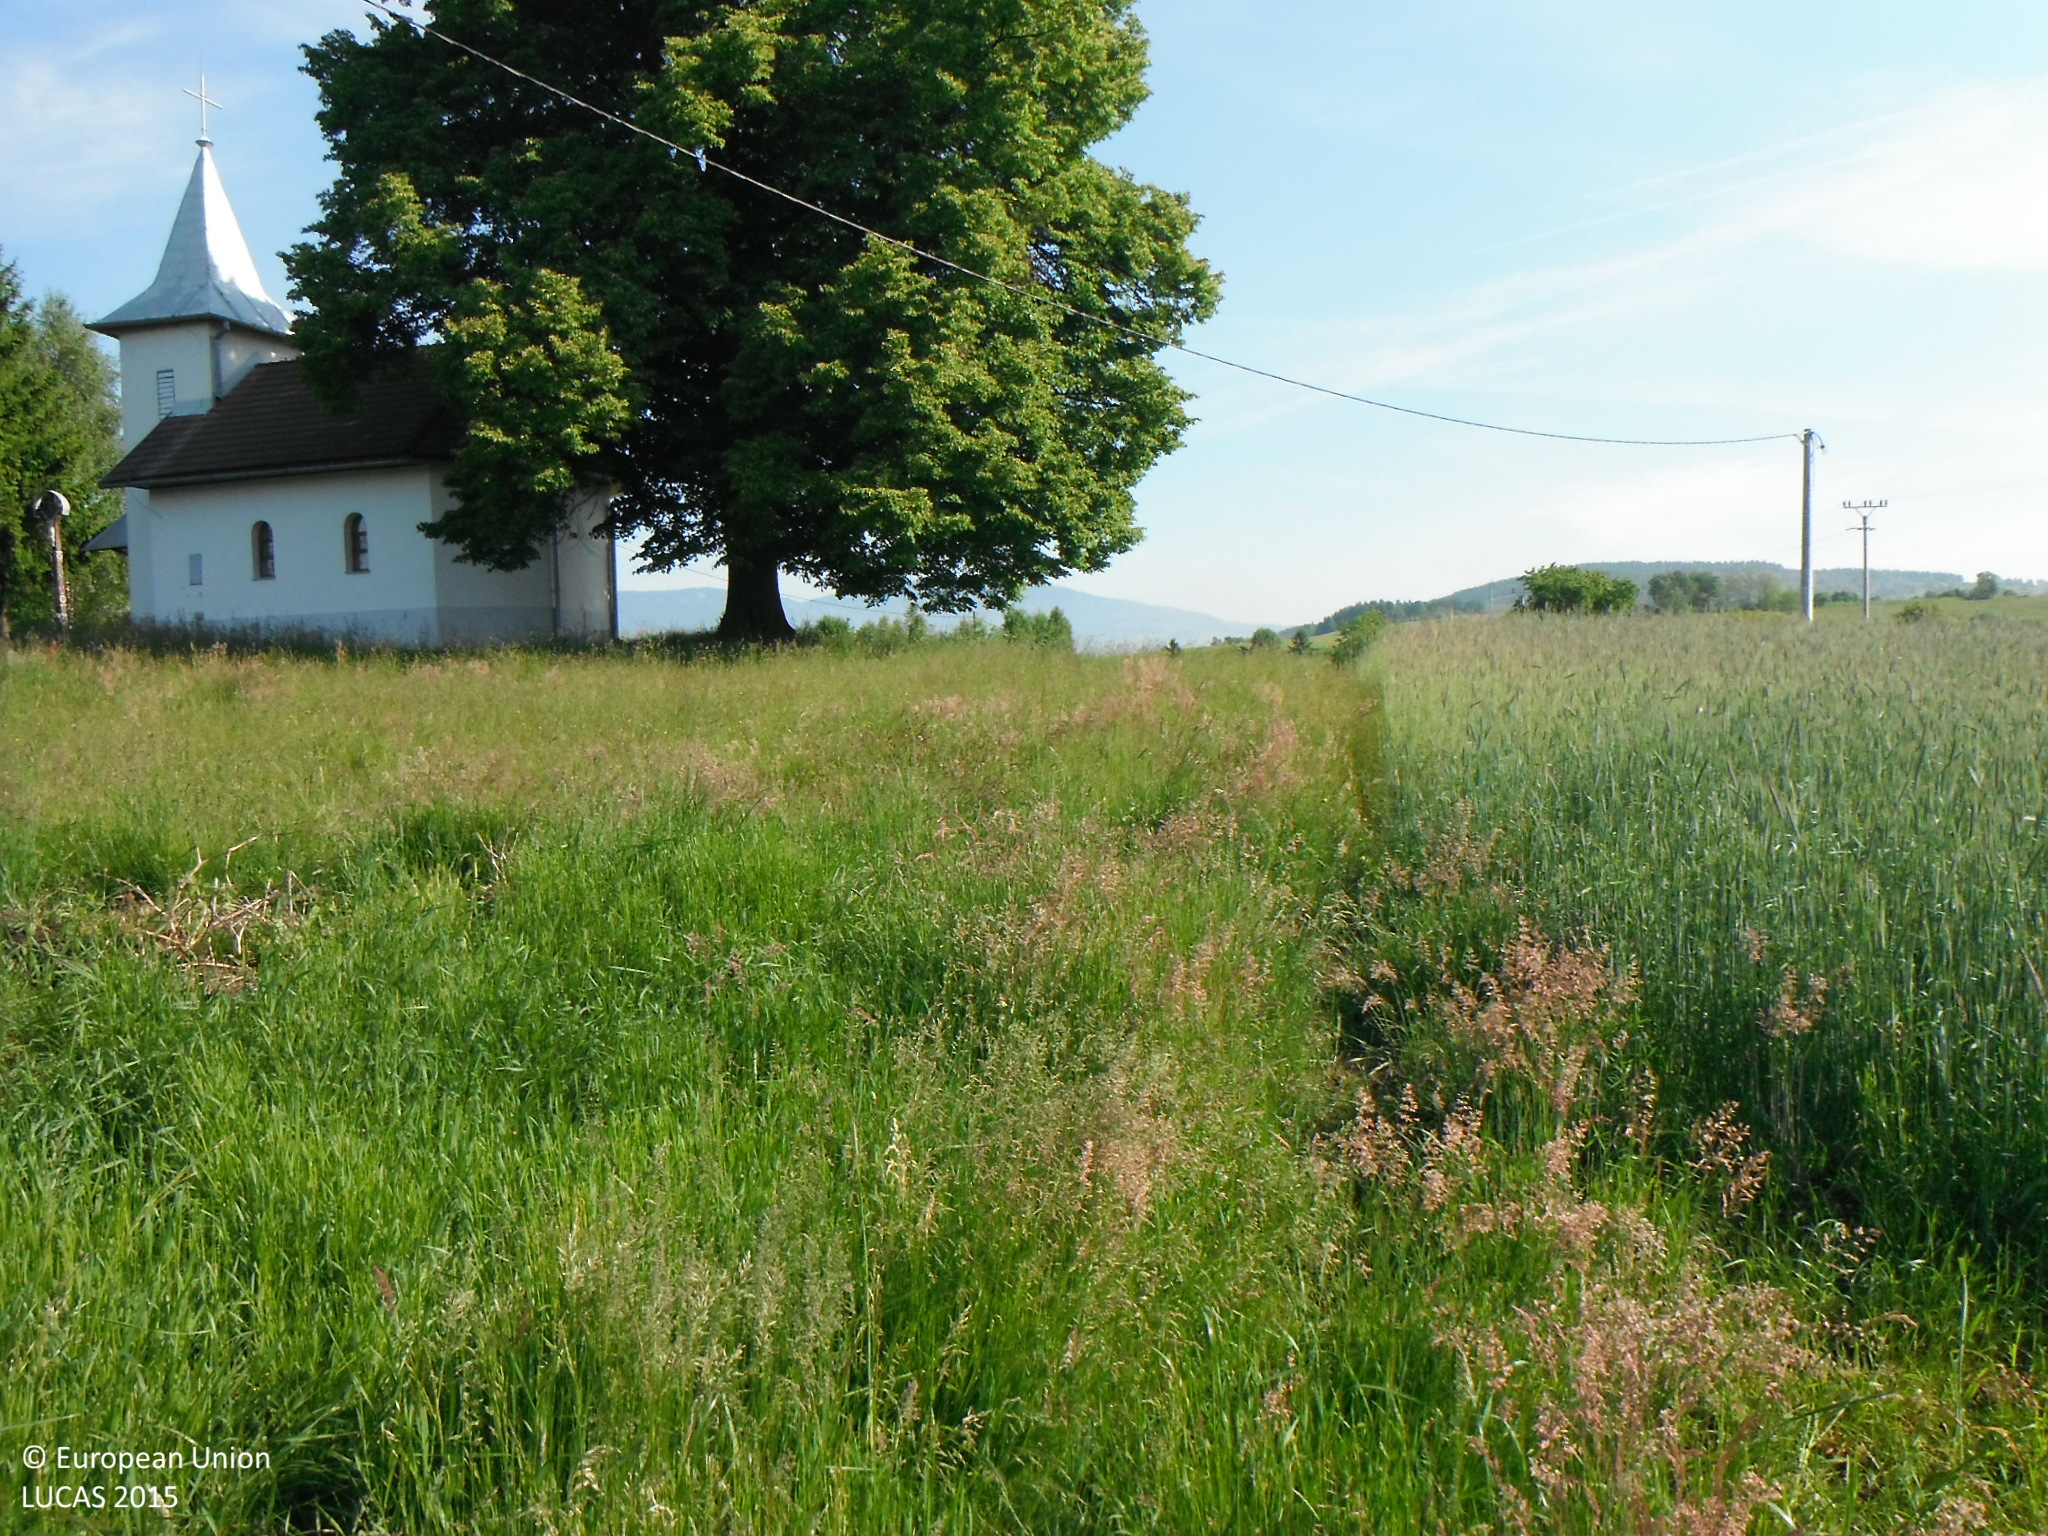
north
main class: Grassland
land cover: Grassland without tree/shrub cover
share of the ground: > 75 %
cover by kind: herbaceous plants 95 %, shrubs 5 %
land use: Agriculture (excluding fallow land and kitchen gardens)
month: May
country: SK
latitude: 48.5378
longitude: 19.4919
